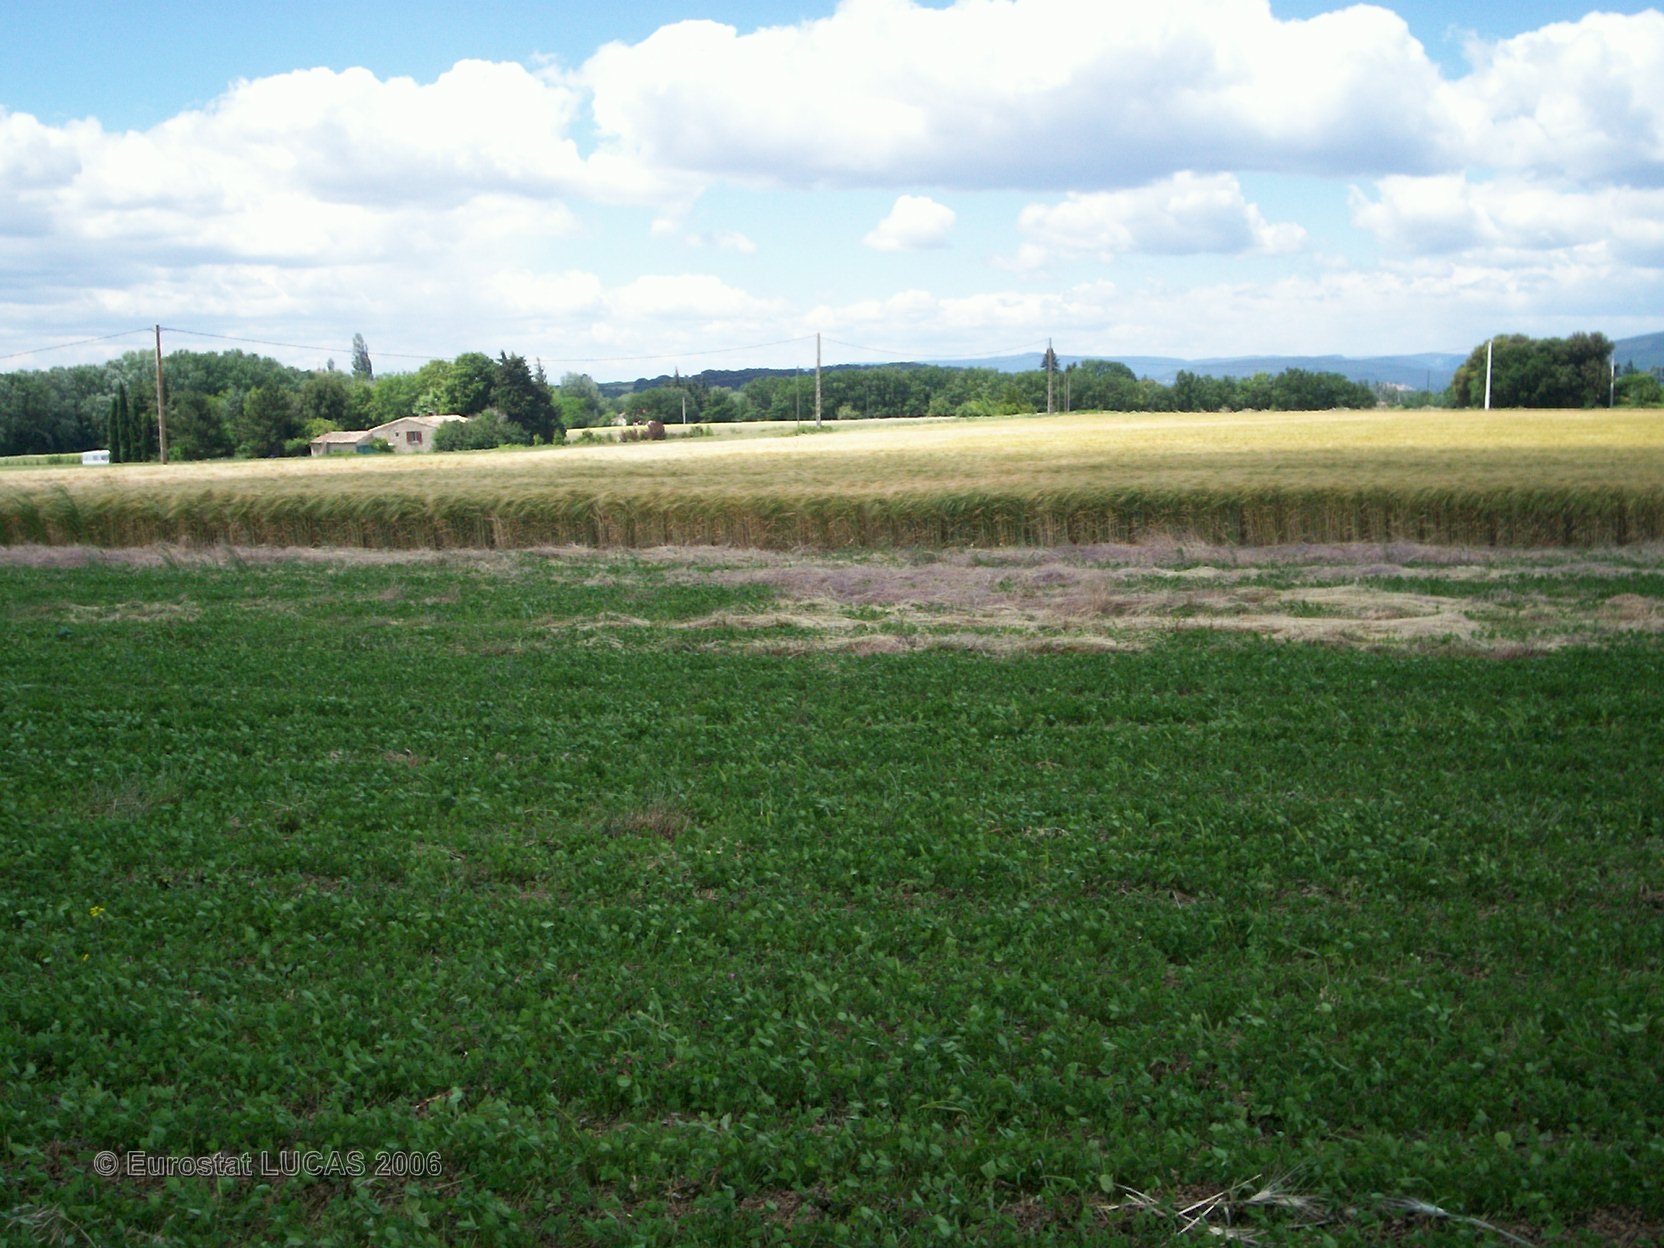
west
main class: Cropland
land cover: Clovers
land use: Agriculture (excluding fallow land and kitchen gardens)
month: May
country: FR
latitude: 44.5868
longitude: 4.9054
